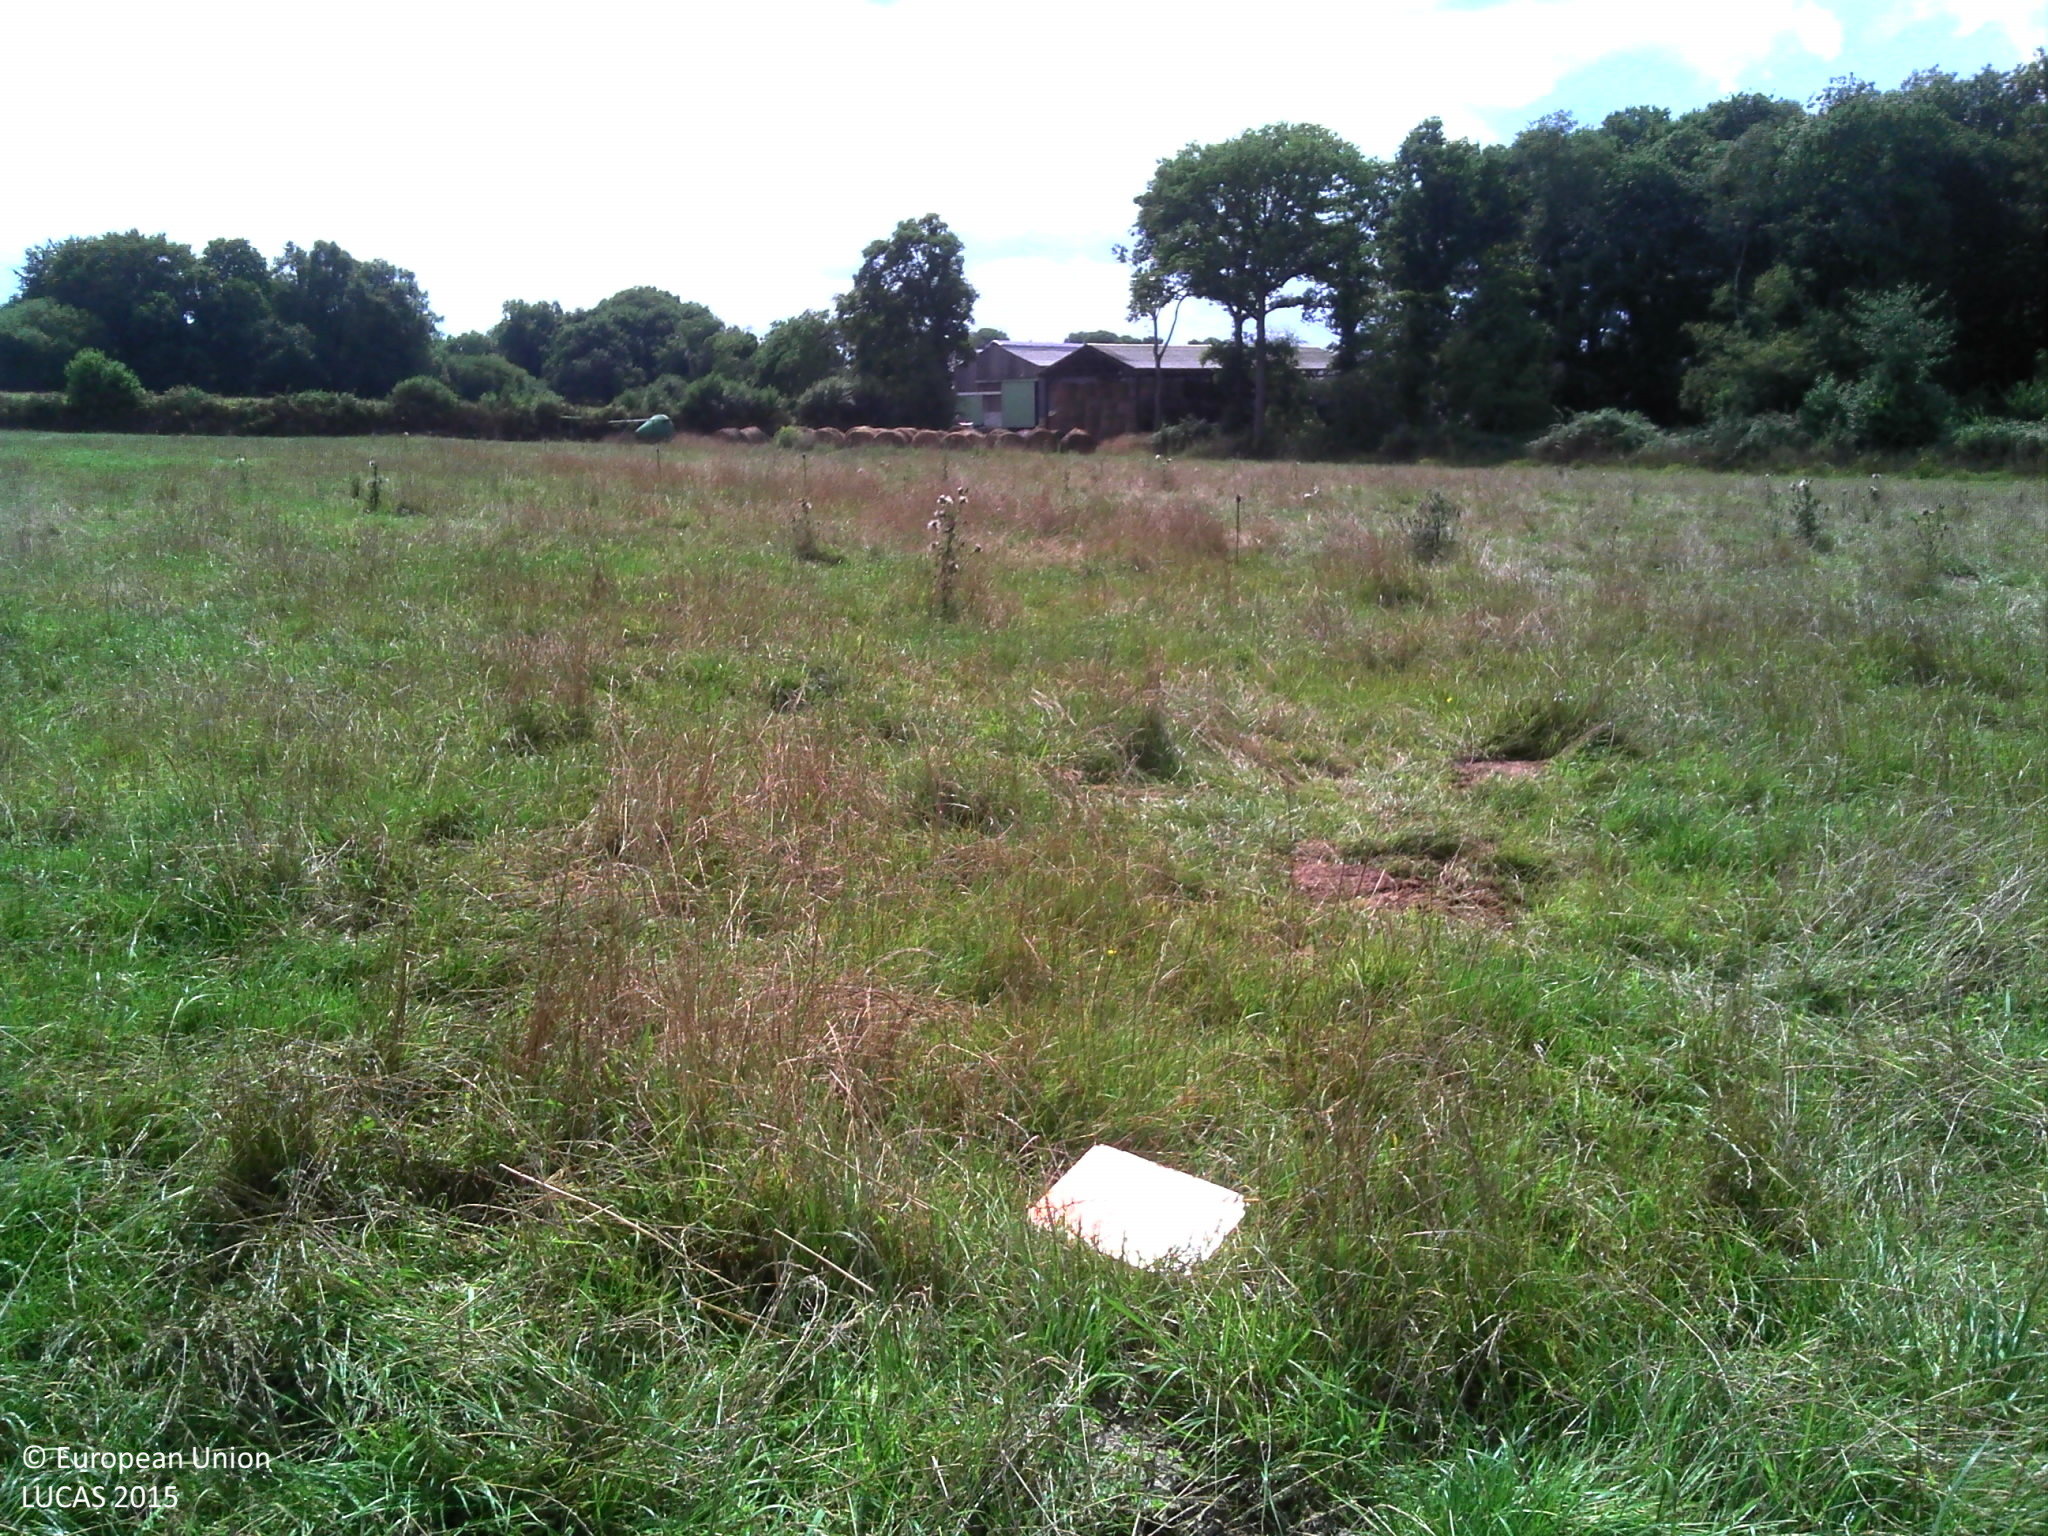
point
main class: Grassland
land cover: Grassland without tree/shrub cover
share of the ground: > 75 %
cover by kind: herbaceous plants 100 %
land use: Agriculture (excluding fallow land and kitchen gardens)
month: August
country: FR
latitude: 48.6471
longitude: -3.1991
